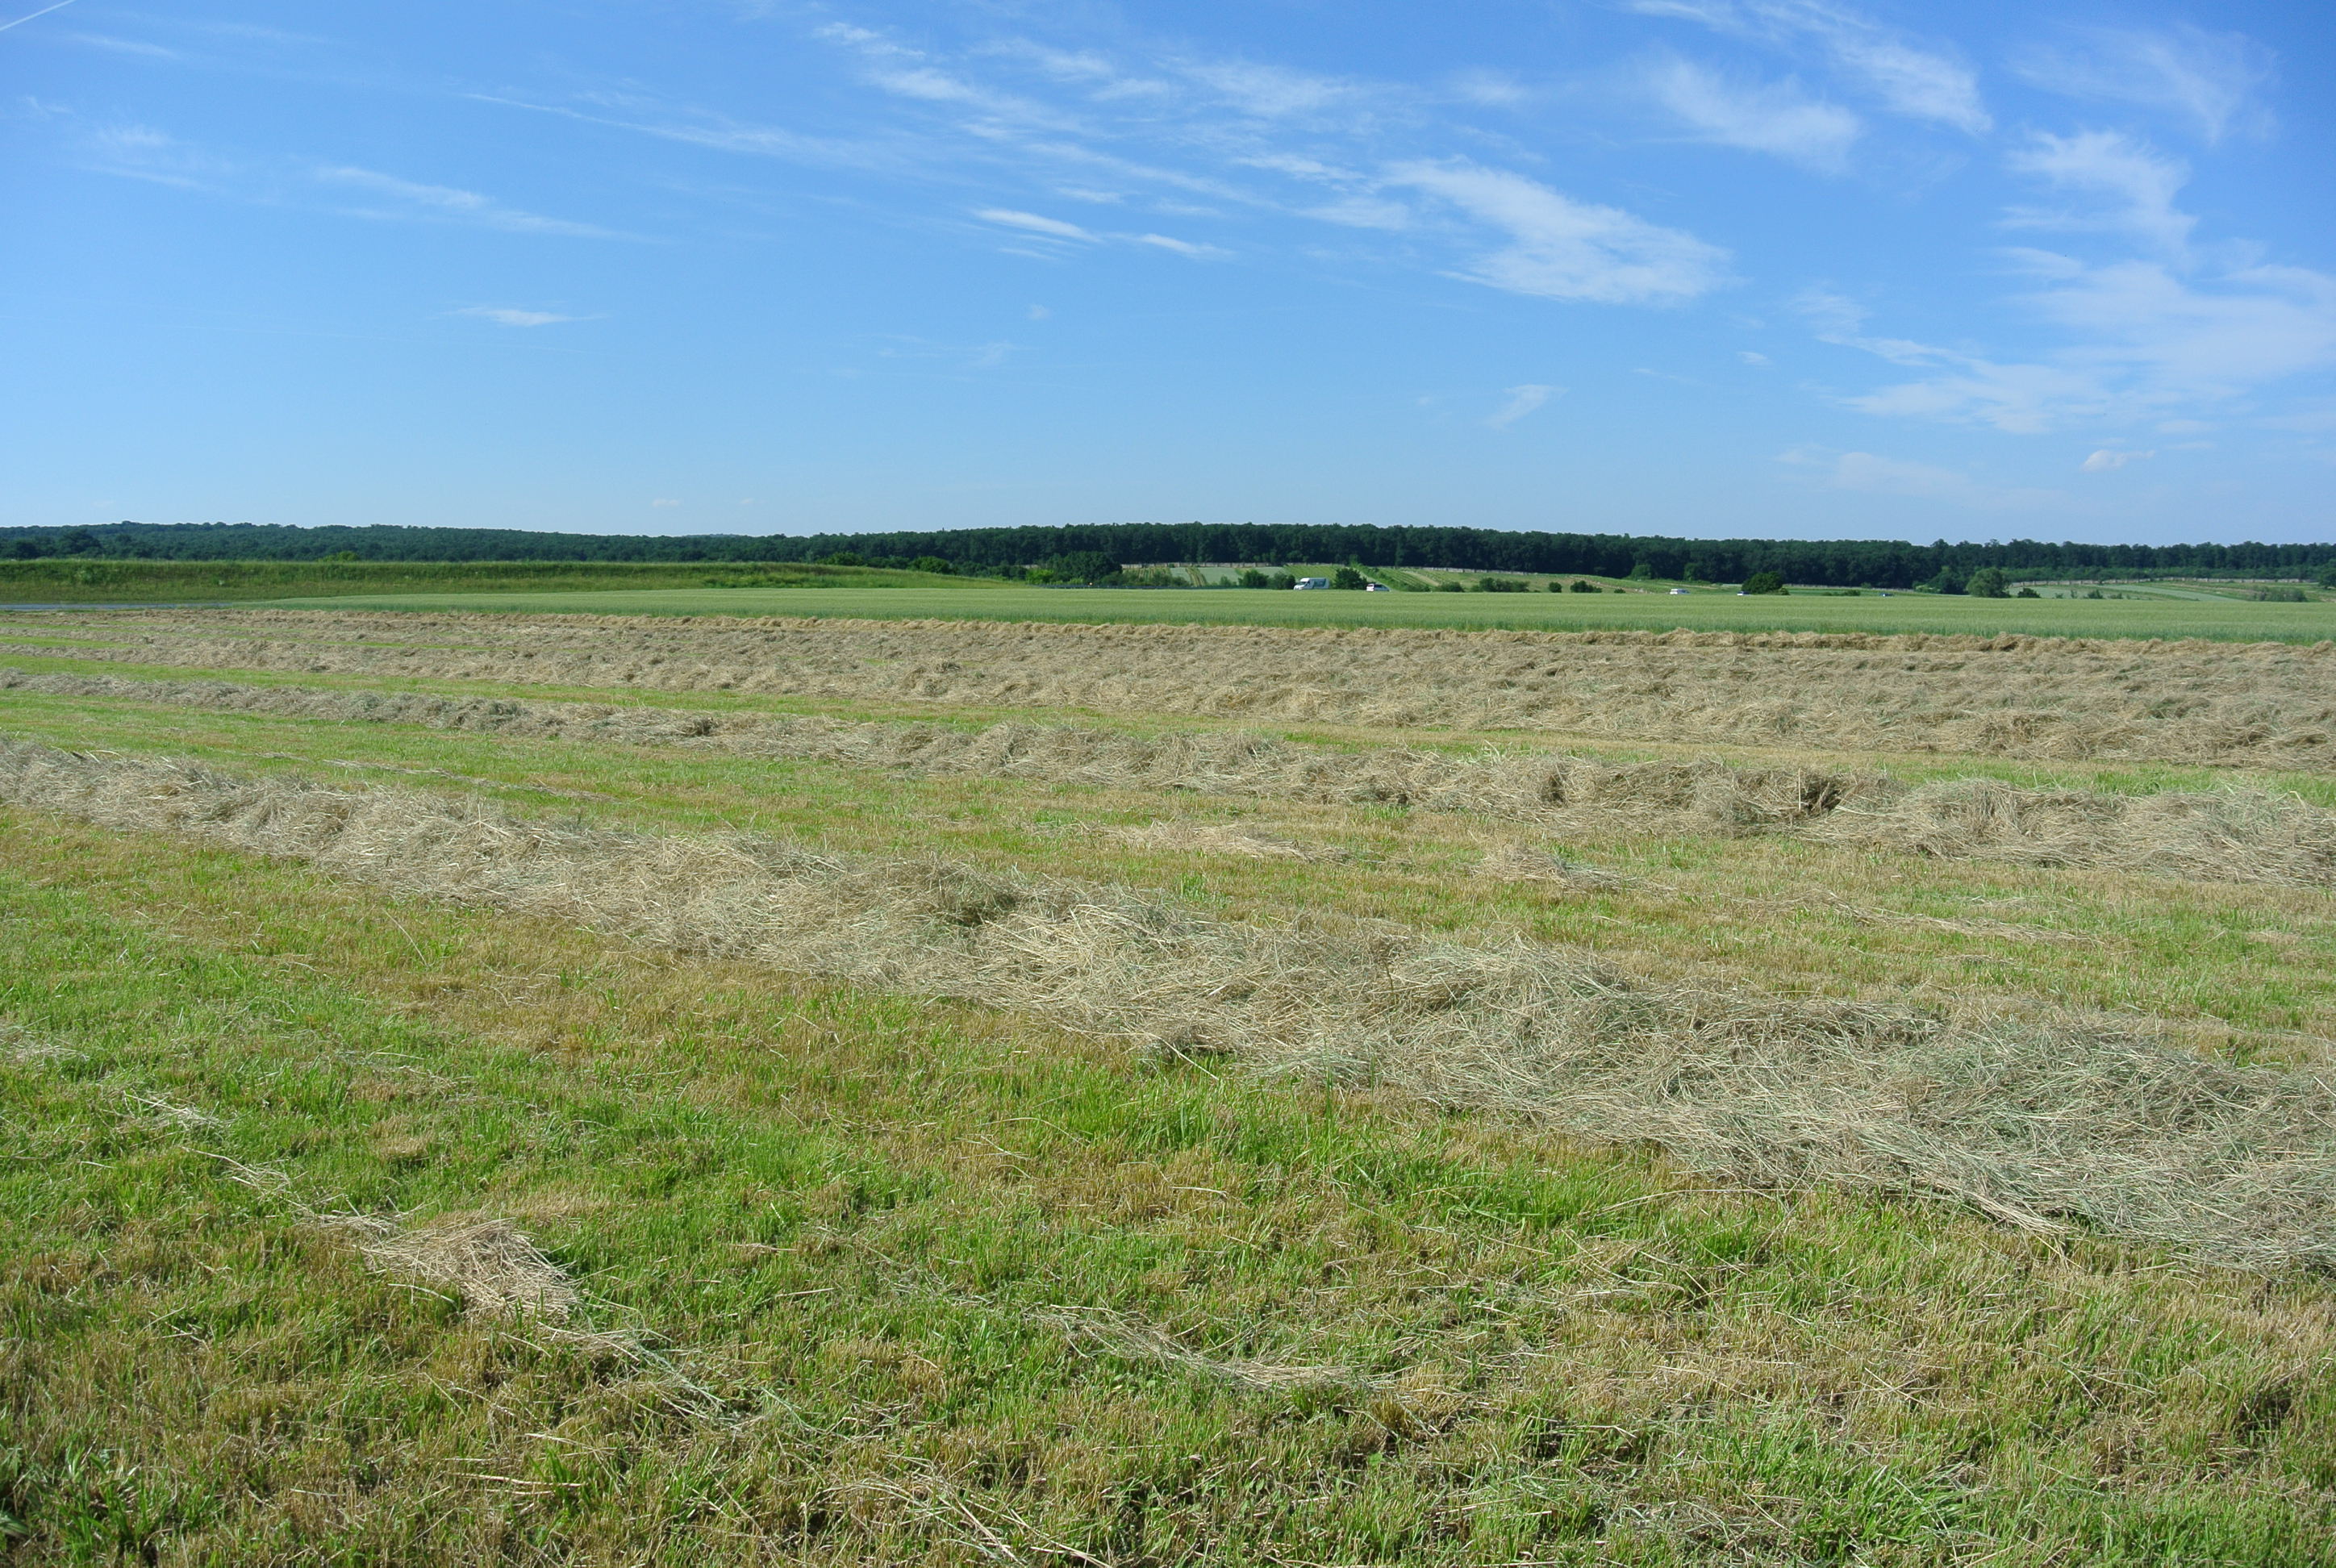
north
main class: Grassland
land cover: Grassland without tree/shrub cover
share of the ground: > 75 %
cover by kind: herbaceous plants 100 %
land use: Agriculture (excluding fallow land and kitchen gardens)
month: June
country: AT
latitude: 47.8619
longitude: 16.6218
